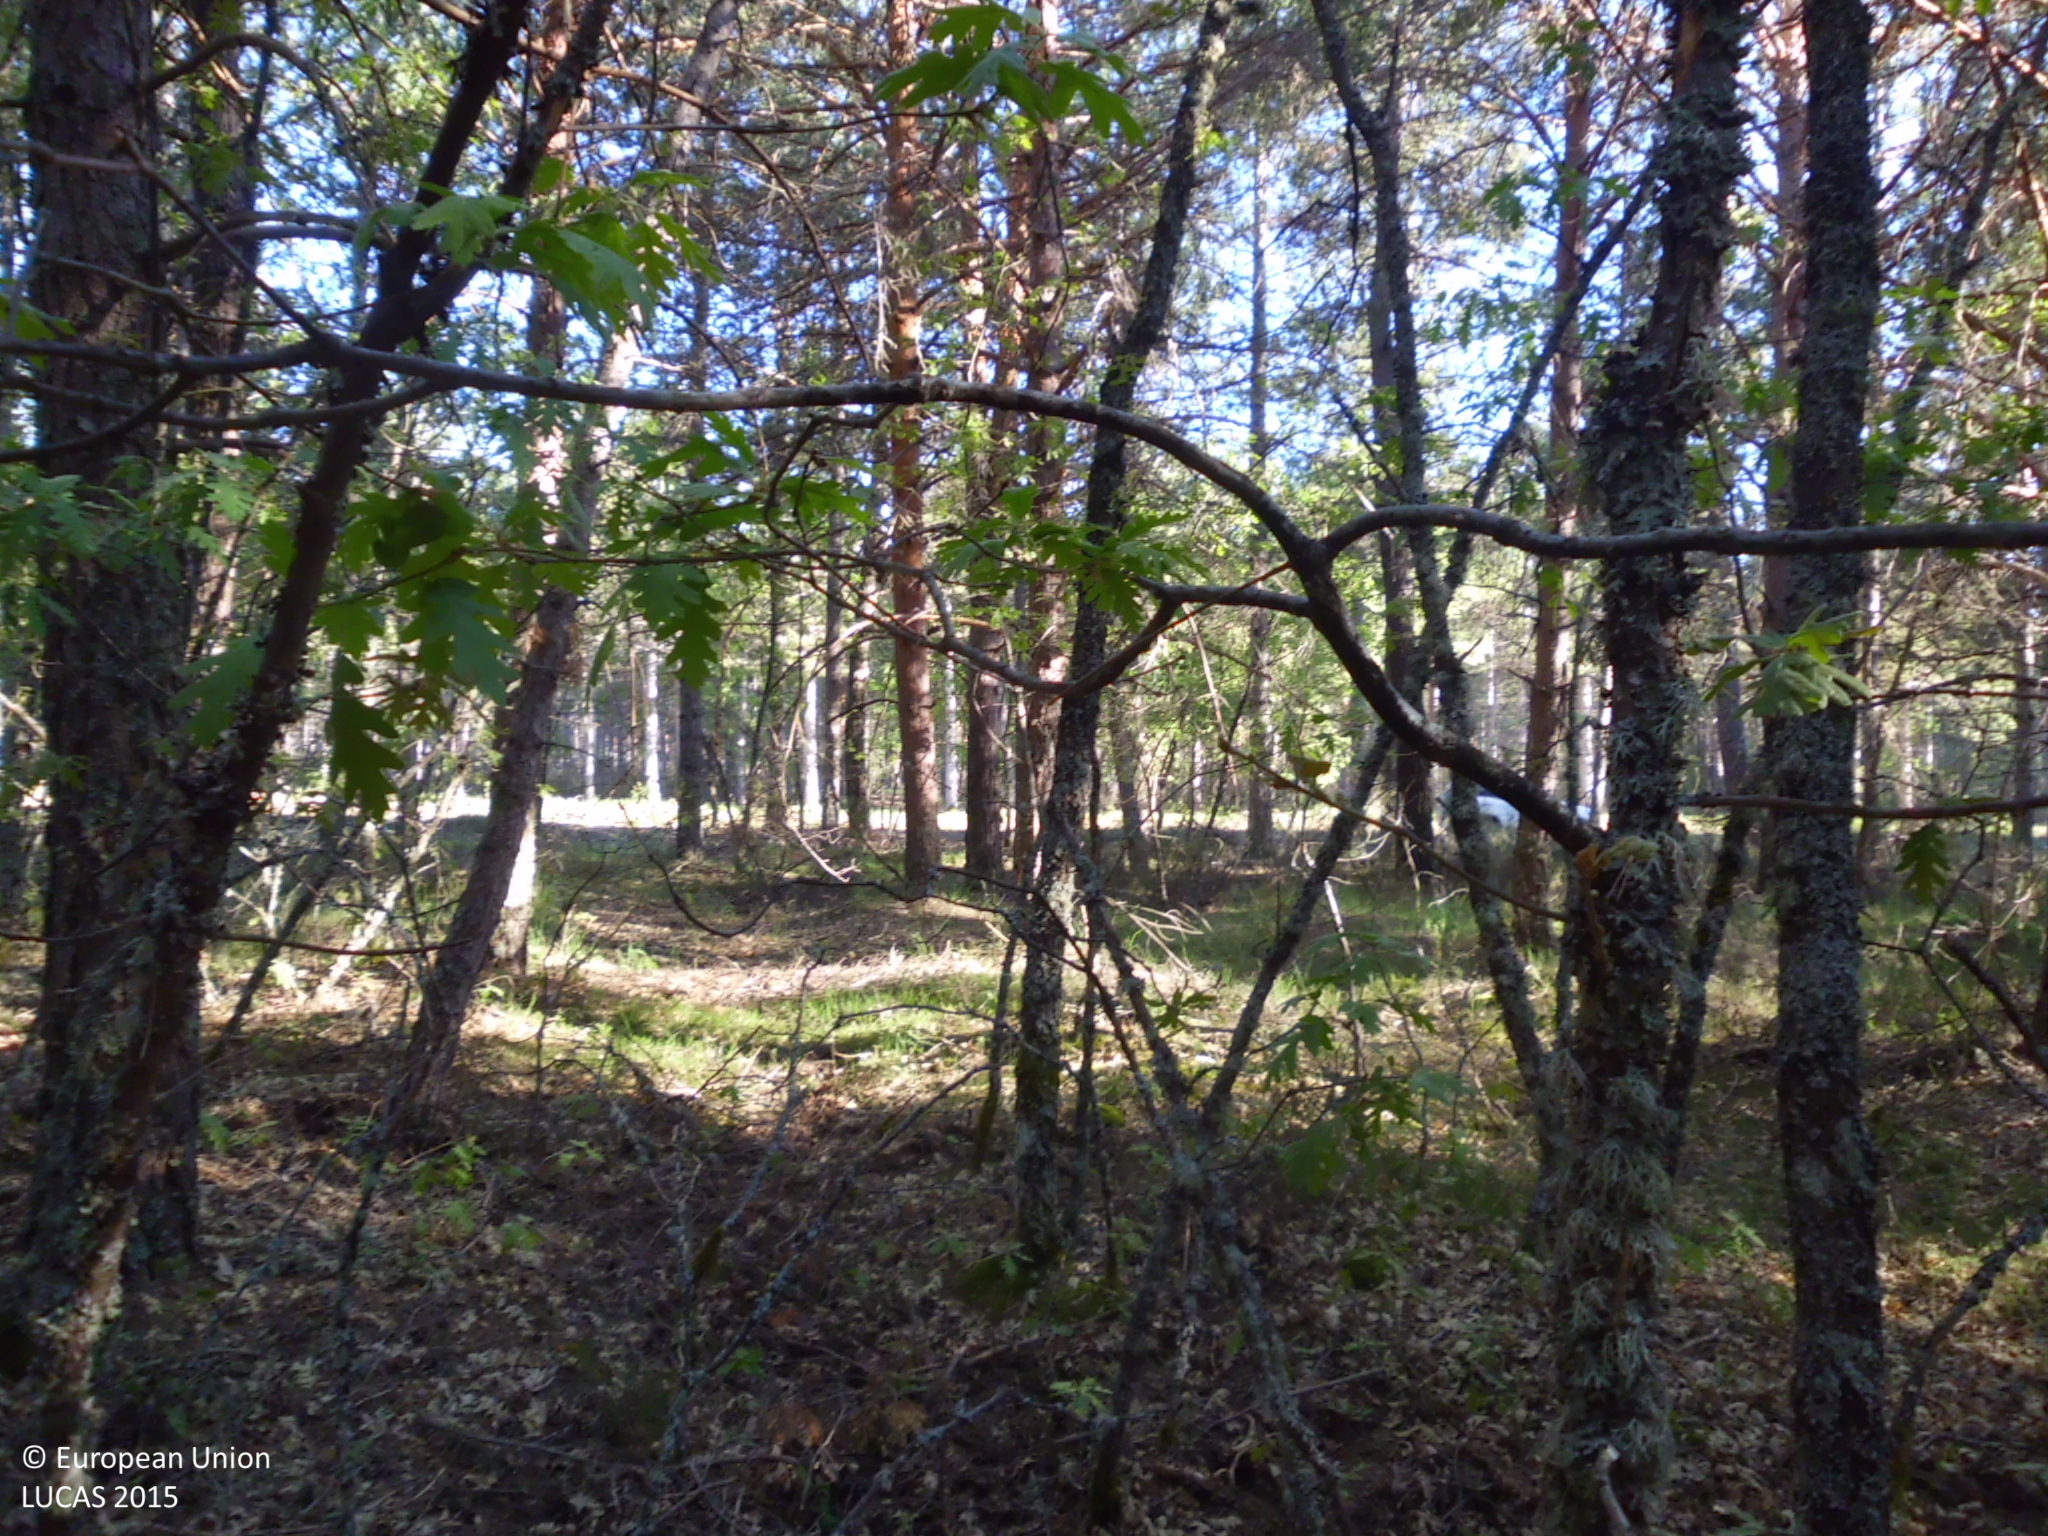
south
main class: Woodland
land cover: Pine dominated coniferous woodland
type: coniferous forest of the mediterranean region
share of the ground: > 75 %
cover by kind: coniferous forest trees 100 %
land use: Forestry
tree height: > 5 m
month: May
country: ES
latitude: 42.6866
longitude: -4.8643
